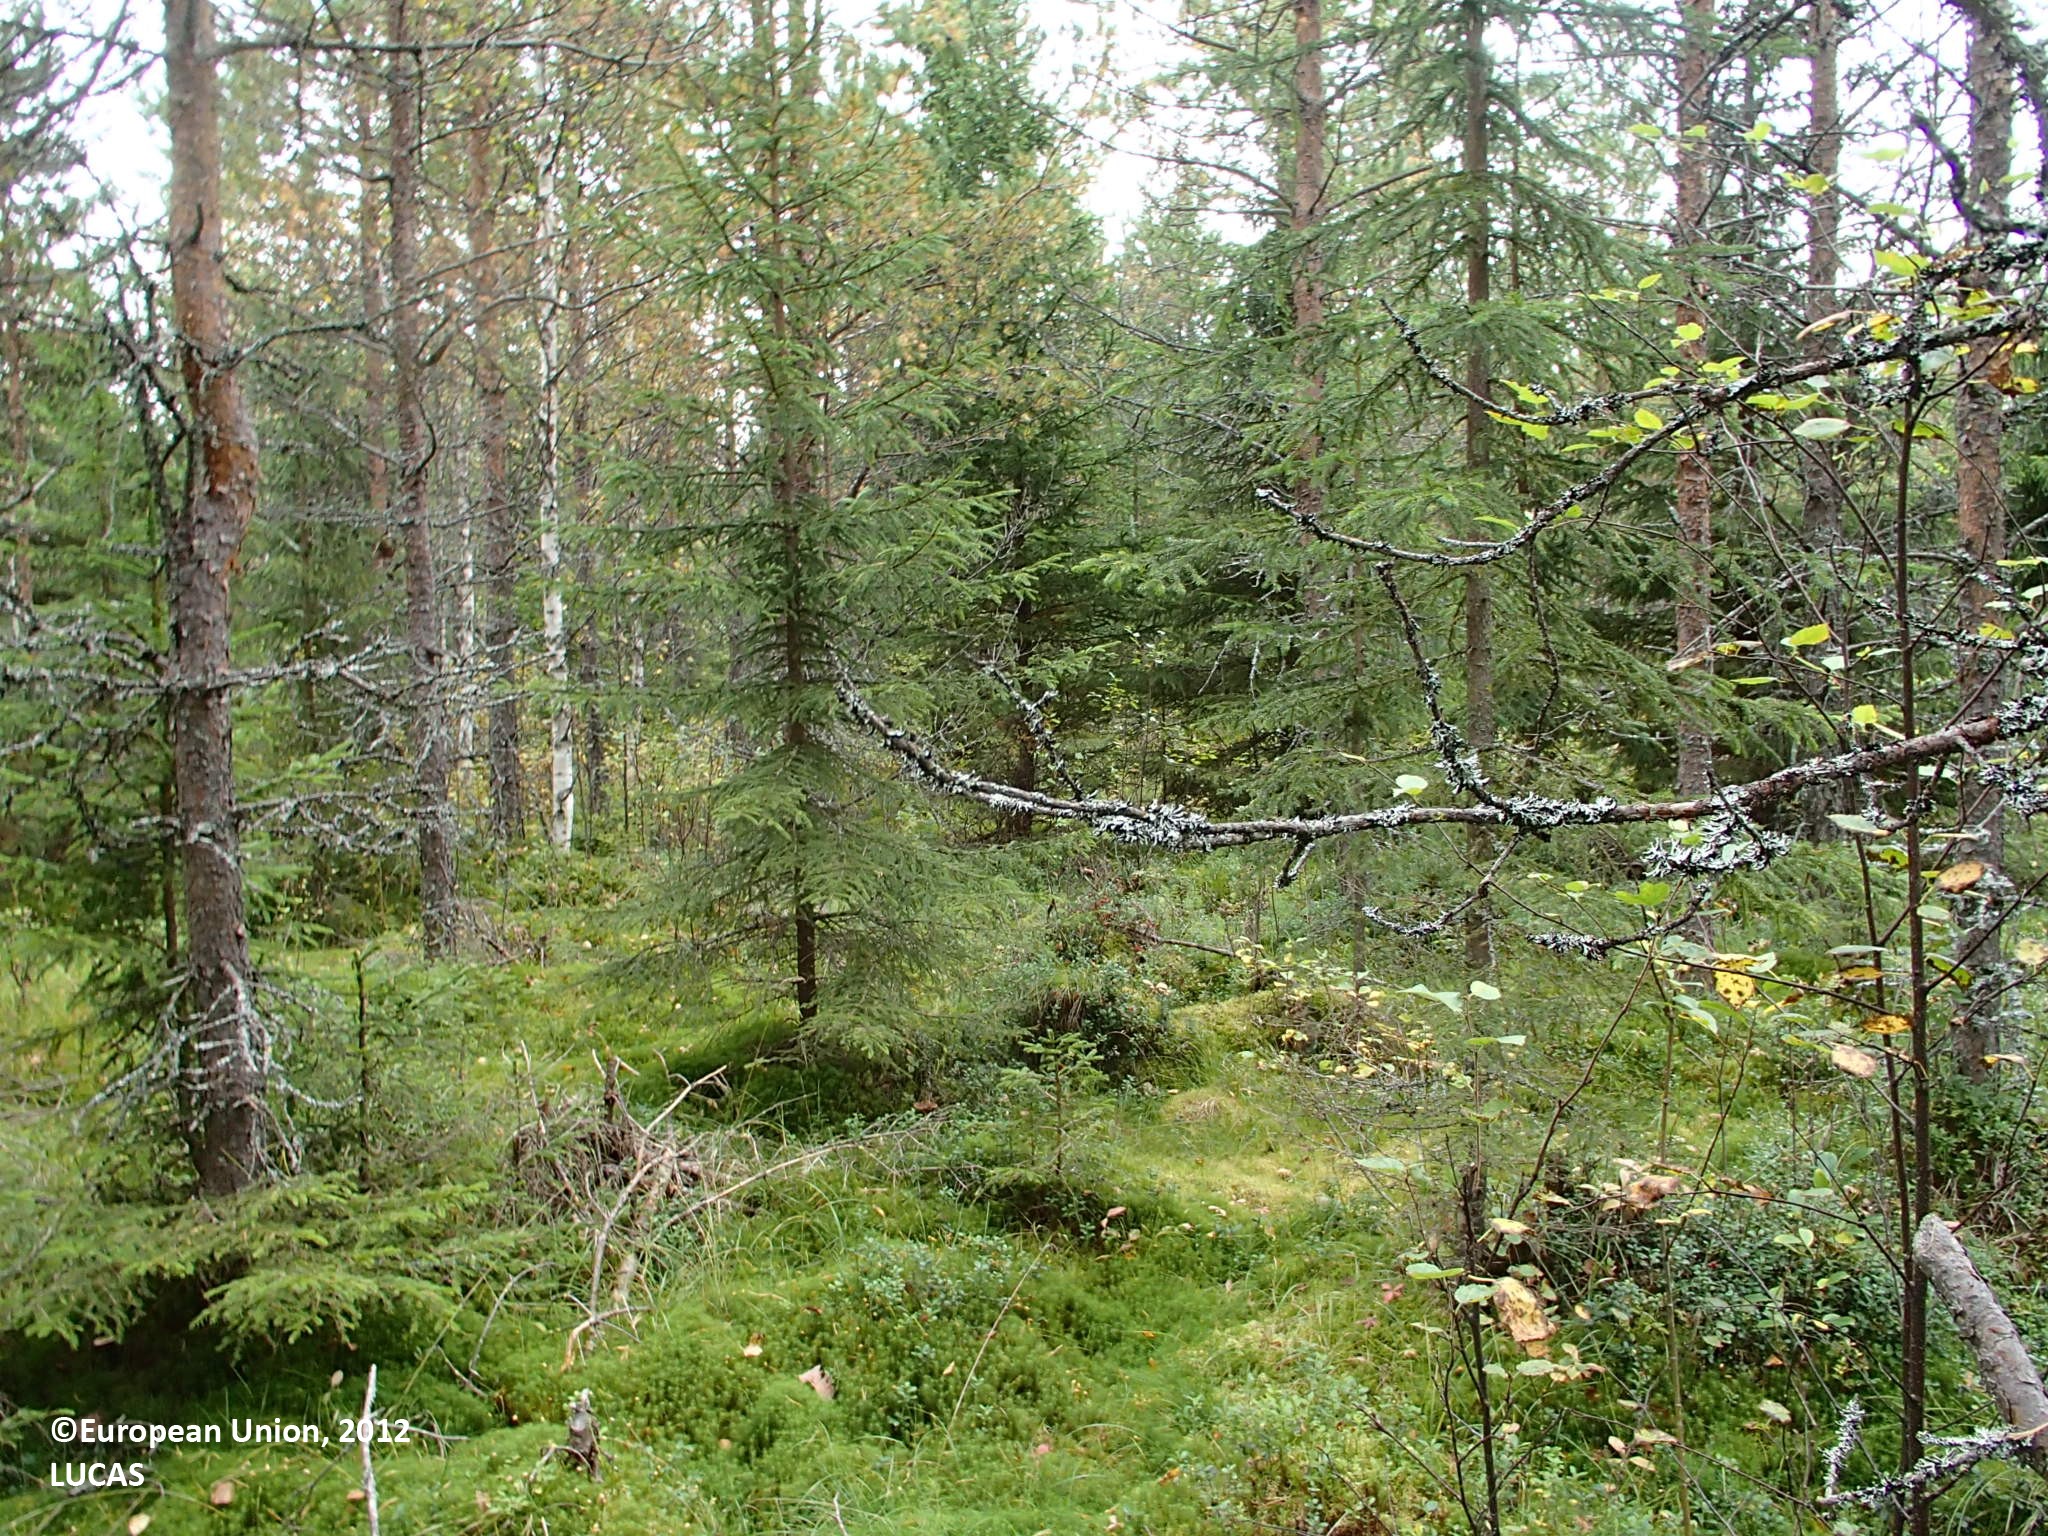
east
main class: Woodland
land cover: Other coniferous woodland
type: boreal forest
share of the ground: > 75 %
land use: Forestry
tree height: > 5 m
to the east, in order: Other coniferous woodland; Pine dominated coniferous woodland; Other coniferous woodland; Ditches and canals; Pine dominated coniferous woodland; Other coniferous woodland; Pine dominated coniferous woodland
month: September
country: FI
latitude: 63.8523
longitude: 26.0355
